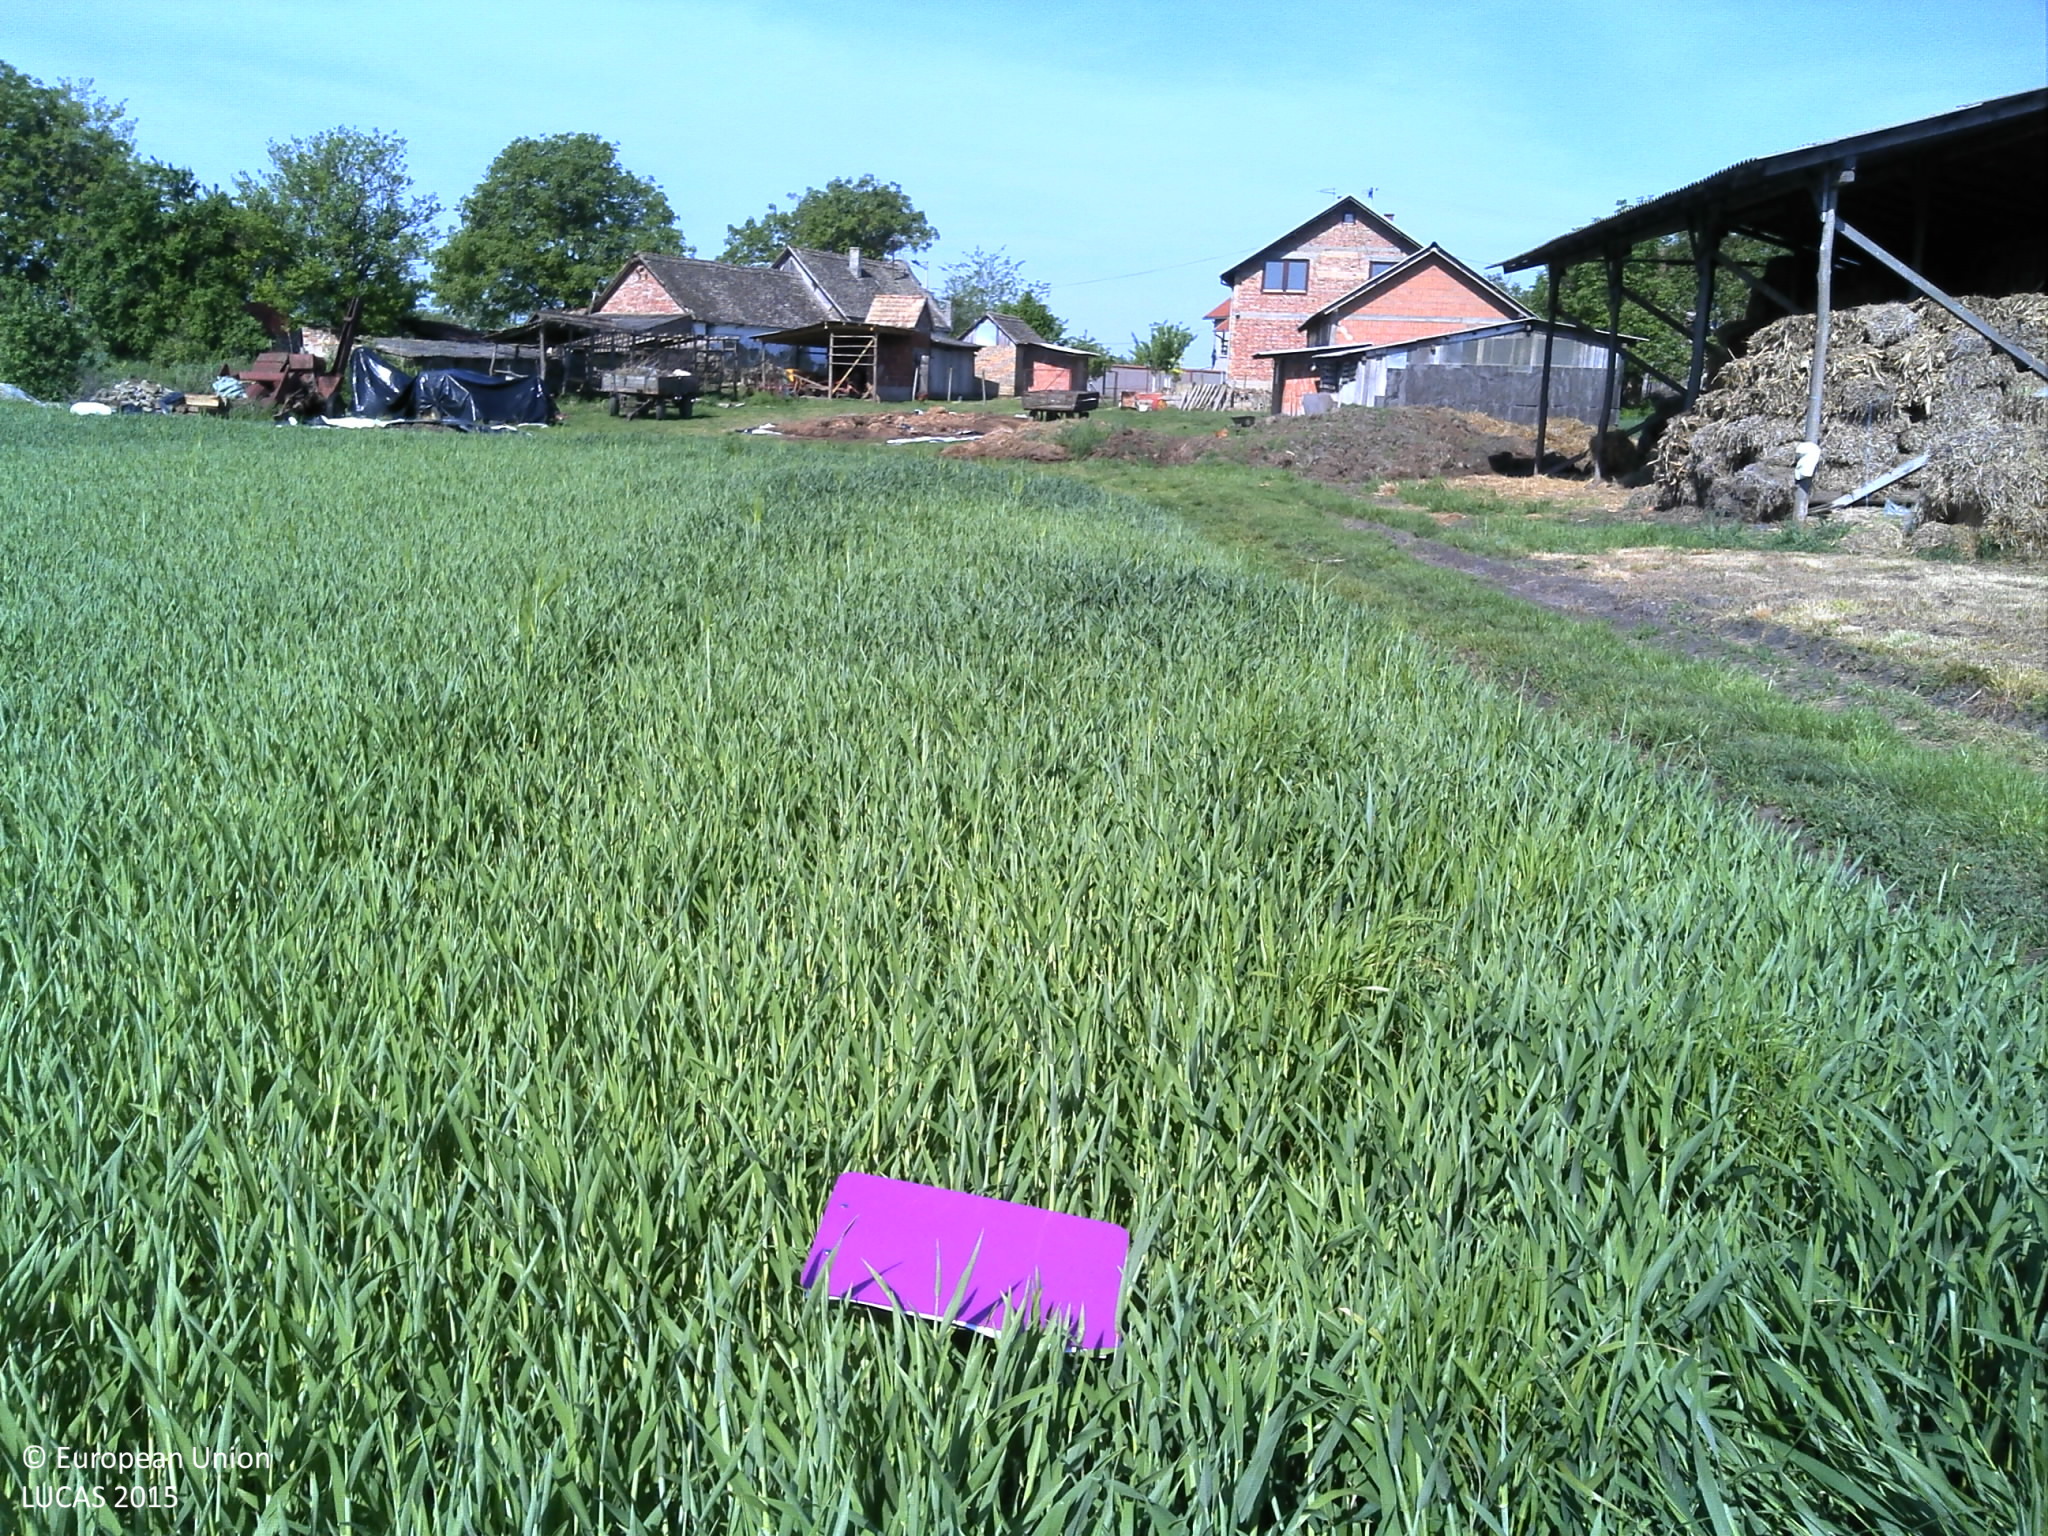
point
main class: Cropland
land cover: Common wheat
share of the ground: > 75 %
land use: Agriculture (excluding fallow land and kitchen gardens)
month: May
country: HR
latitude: 45.4545
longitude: 18.8958
